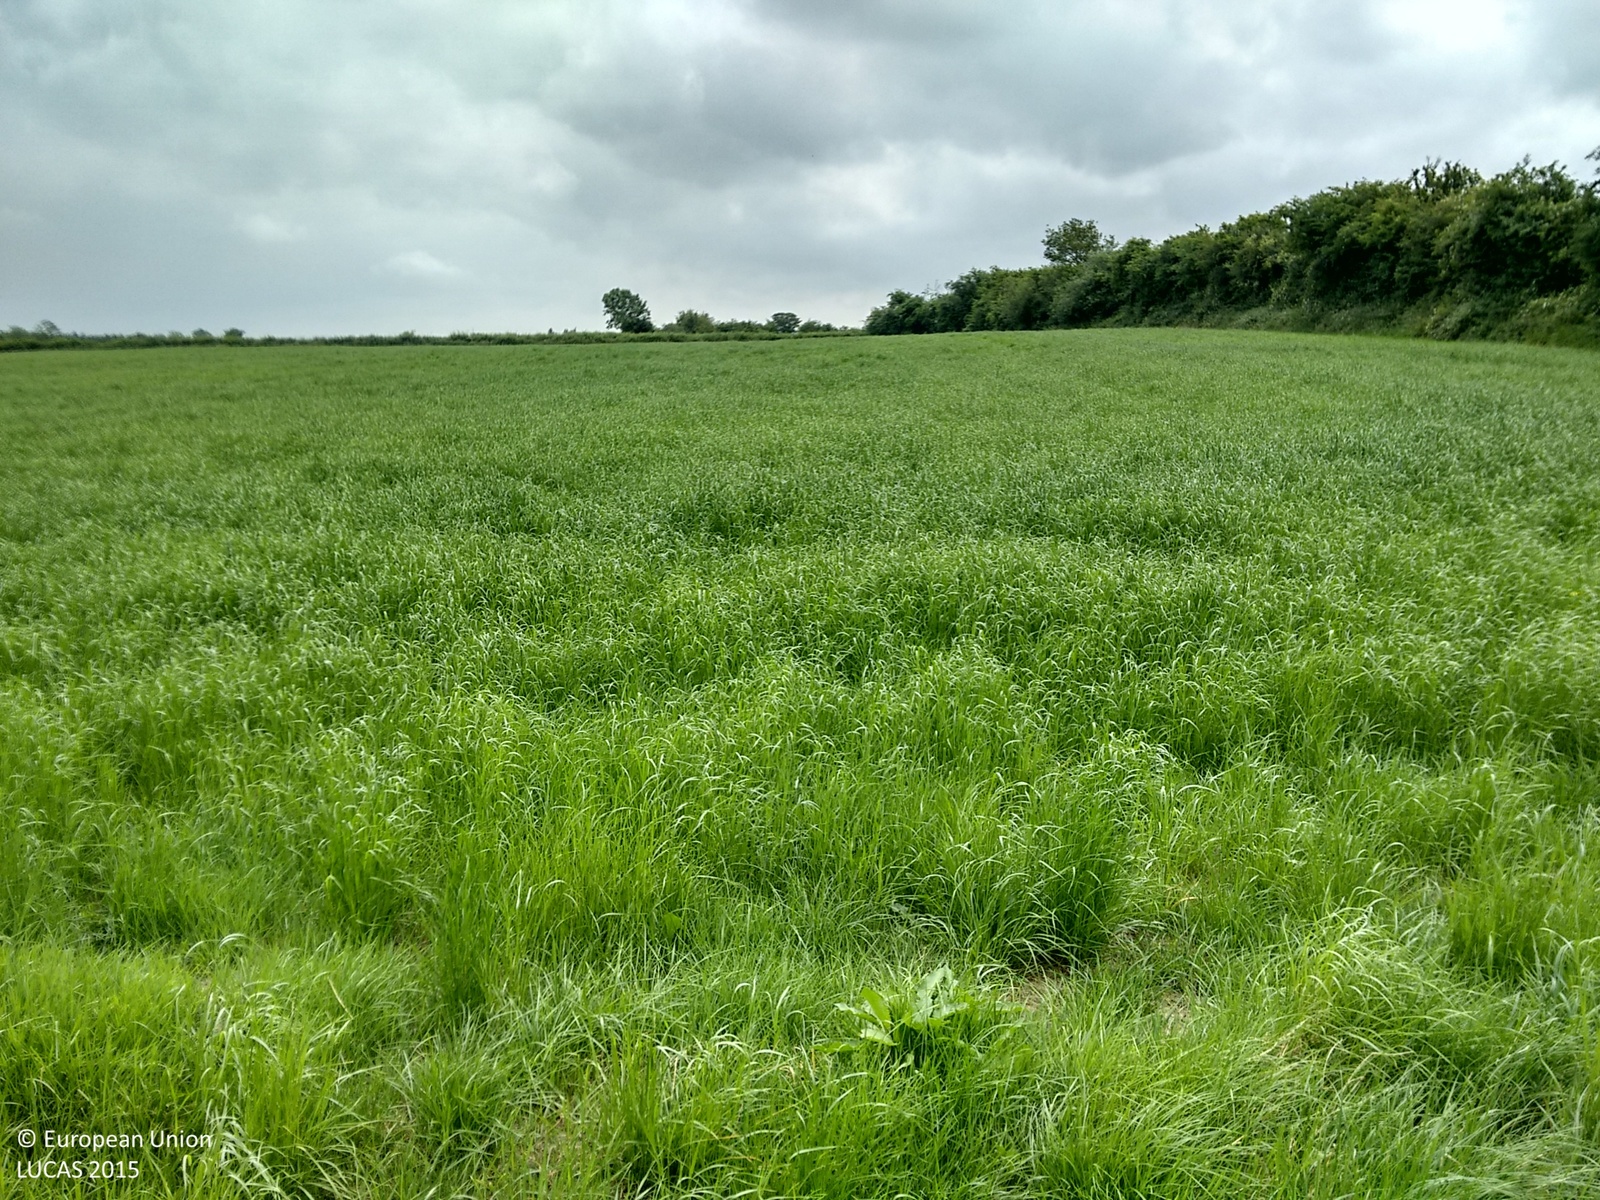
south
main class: Grassland
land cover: Grassland without tree/shrub cover
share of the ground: > 75 %
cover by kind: herbaceous plants 100 %
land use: Agriculture (excluding fallow land and kitchen gardens)
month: July
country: IE
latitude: 52.5302
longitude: -7.4179
